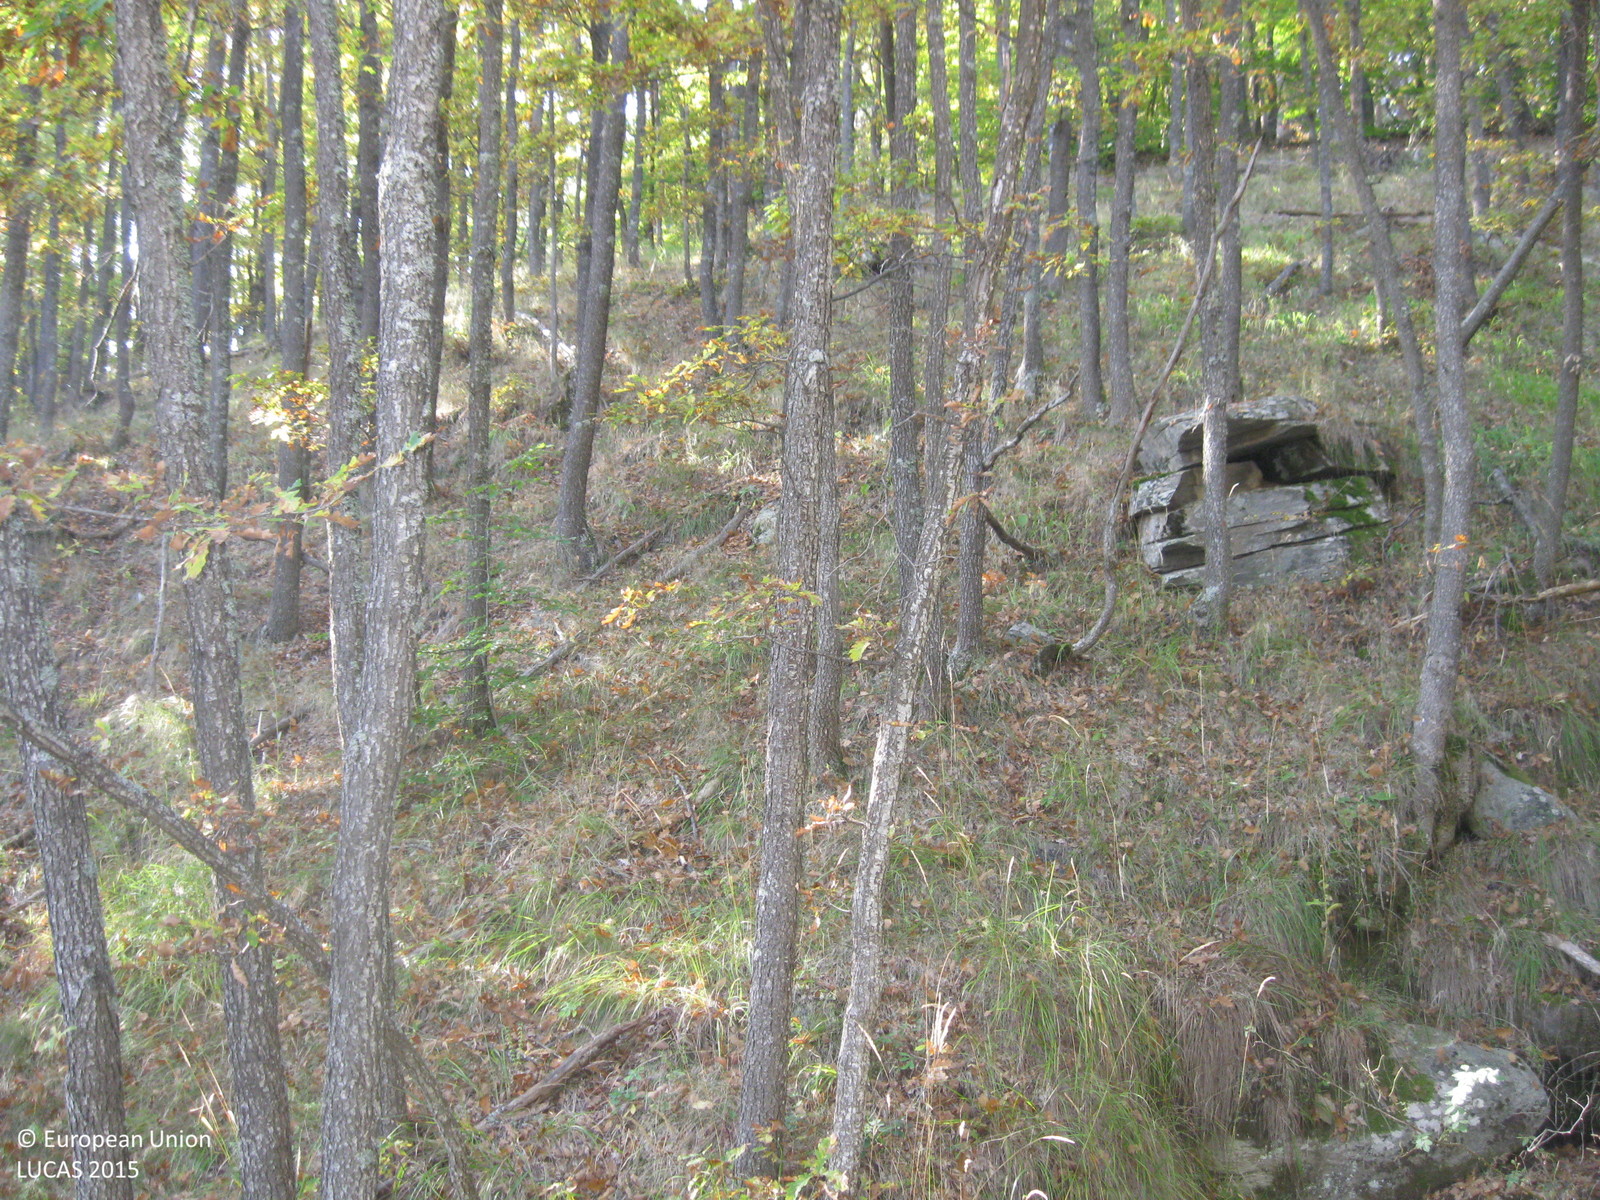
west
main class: Woodland
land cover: Broadleaved woodland
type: mesophytic deciduous forest
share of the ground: > 75 %
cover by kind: broadleaved forest trees 90 %, herbaceous plants 10 %
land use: Forestry
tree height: > 5 m
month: October
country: BG
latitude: 41.9338
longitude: 24.7505
